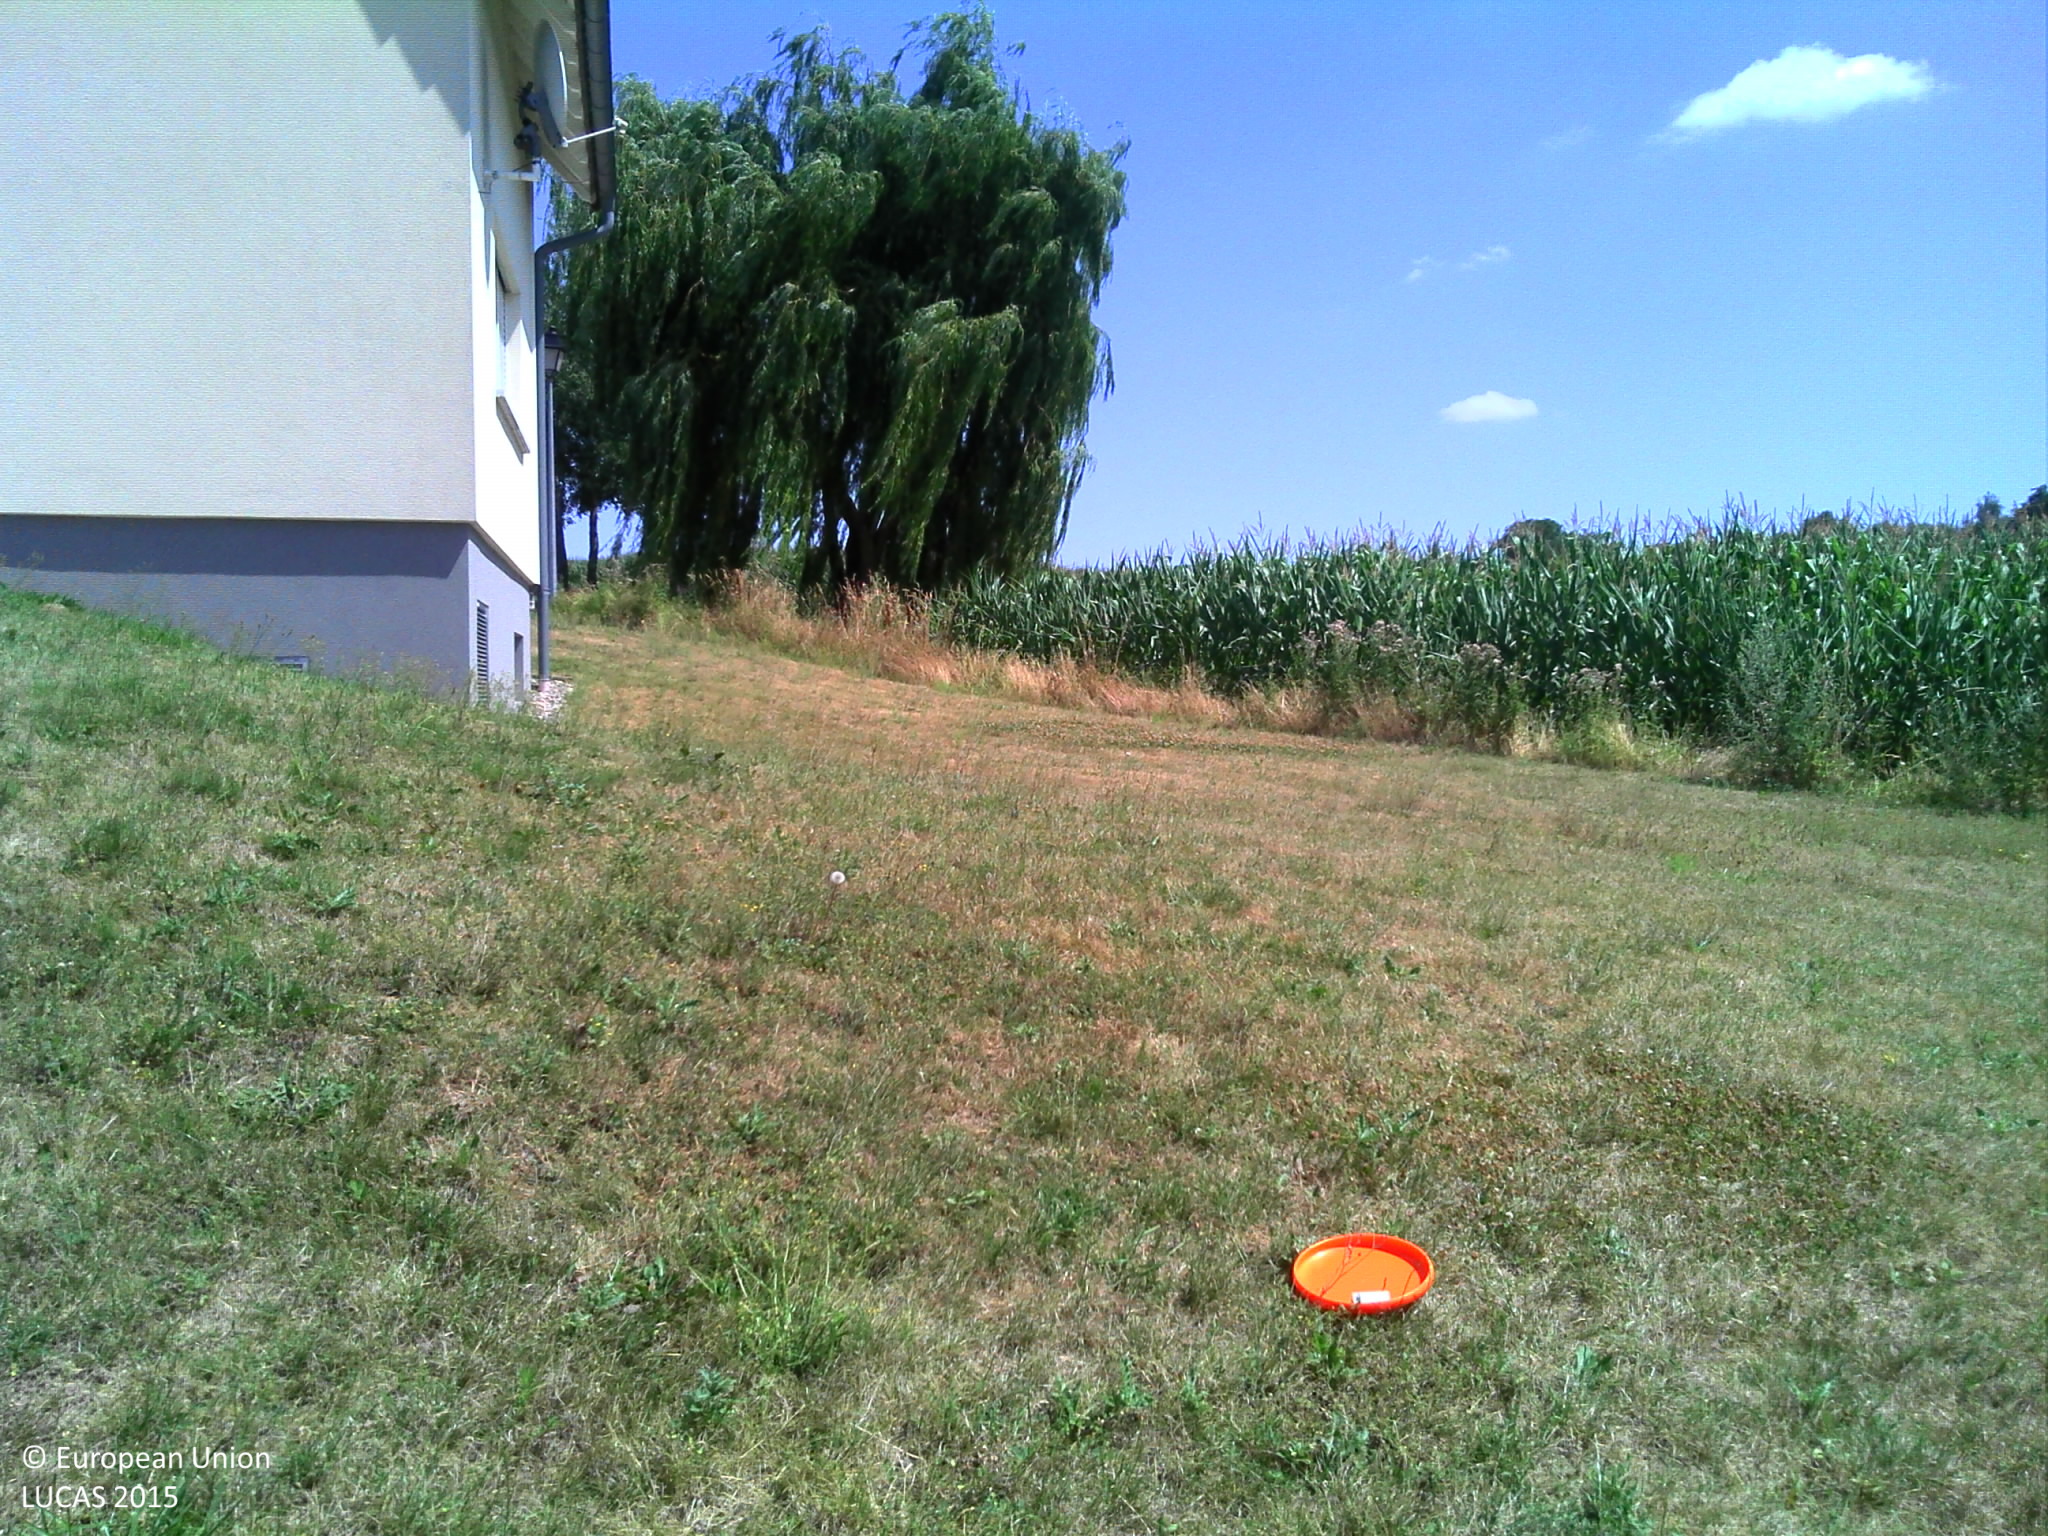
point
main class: Grassland
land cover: Grassland without tree/shrub cover
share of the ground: > 75 %
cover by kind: herbaceous plants 100 %
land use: Residential
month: July
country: FR
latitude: 48.9612
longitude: 7.9929
